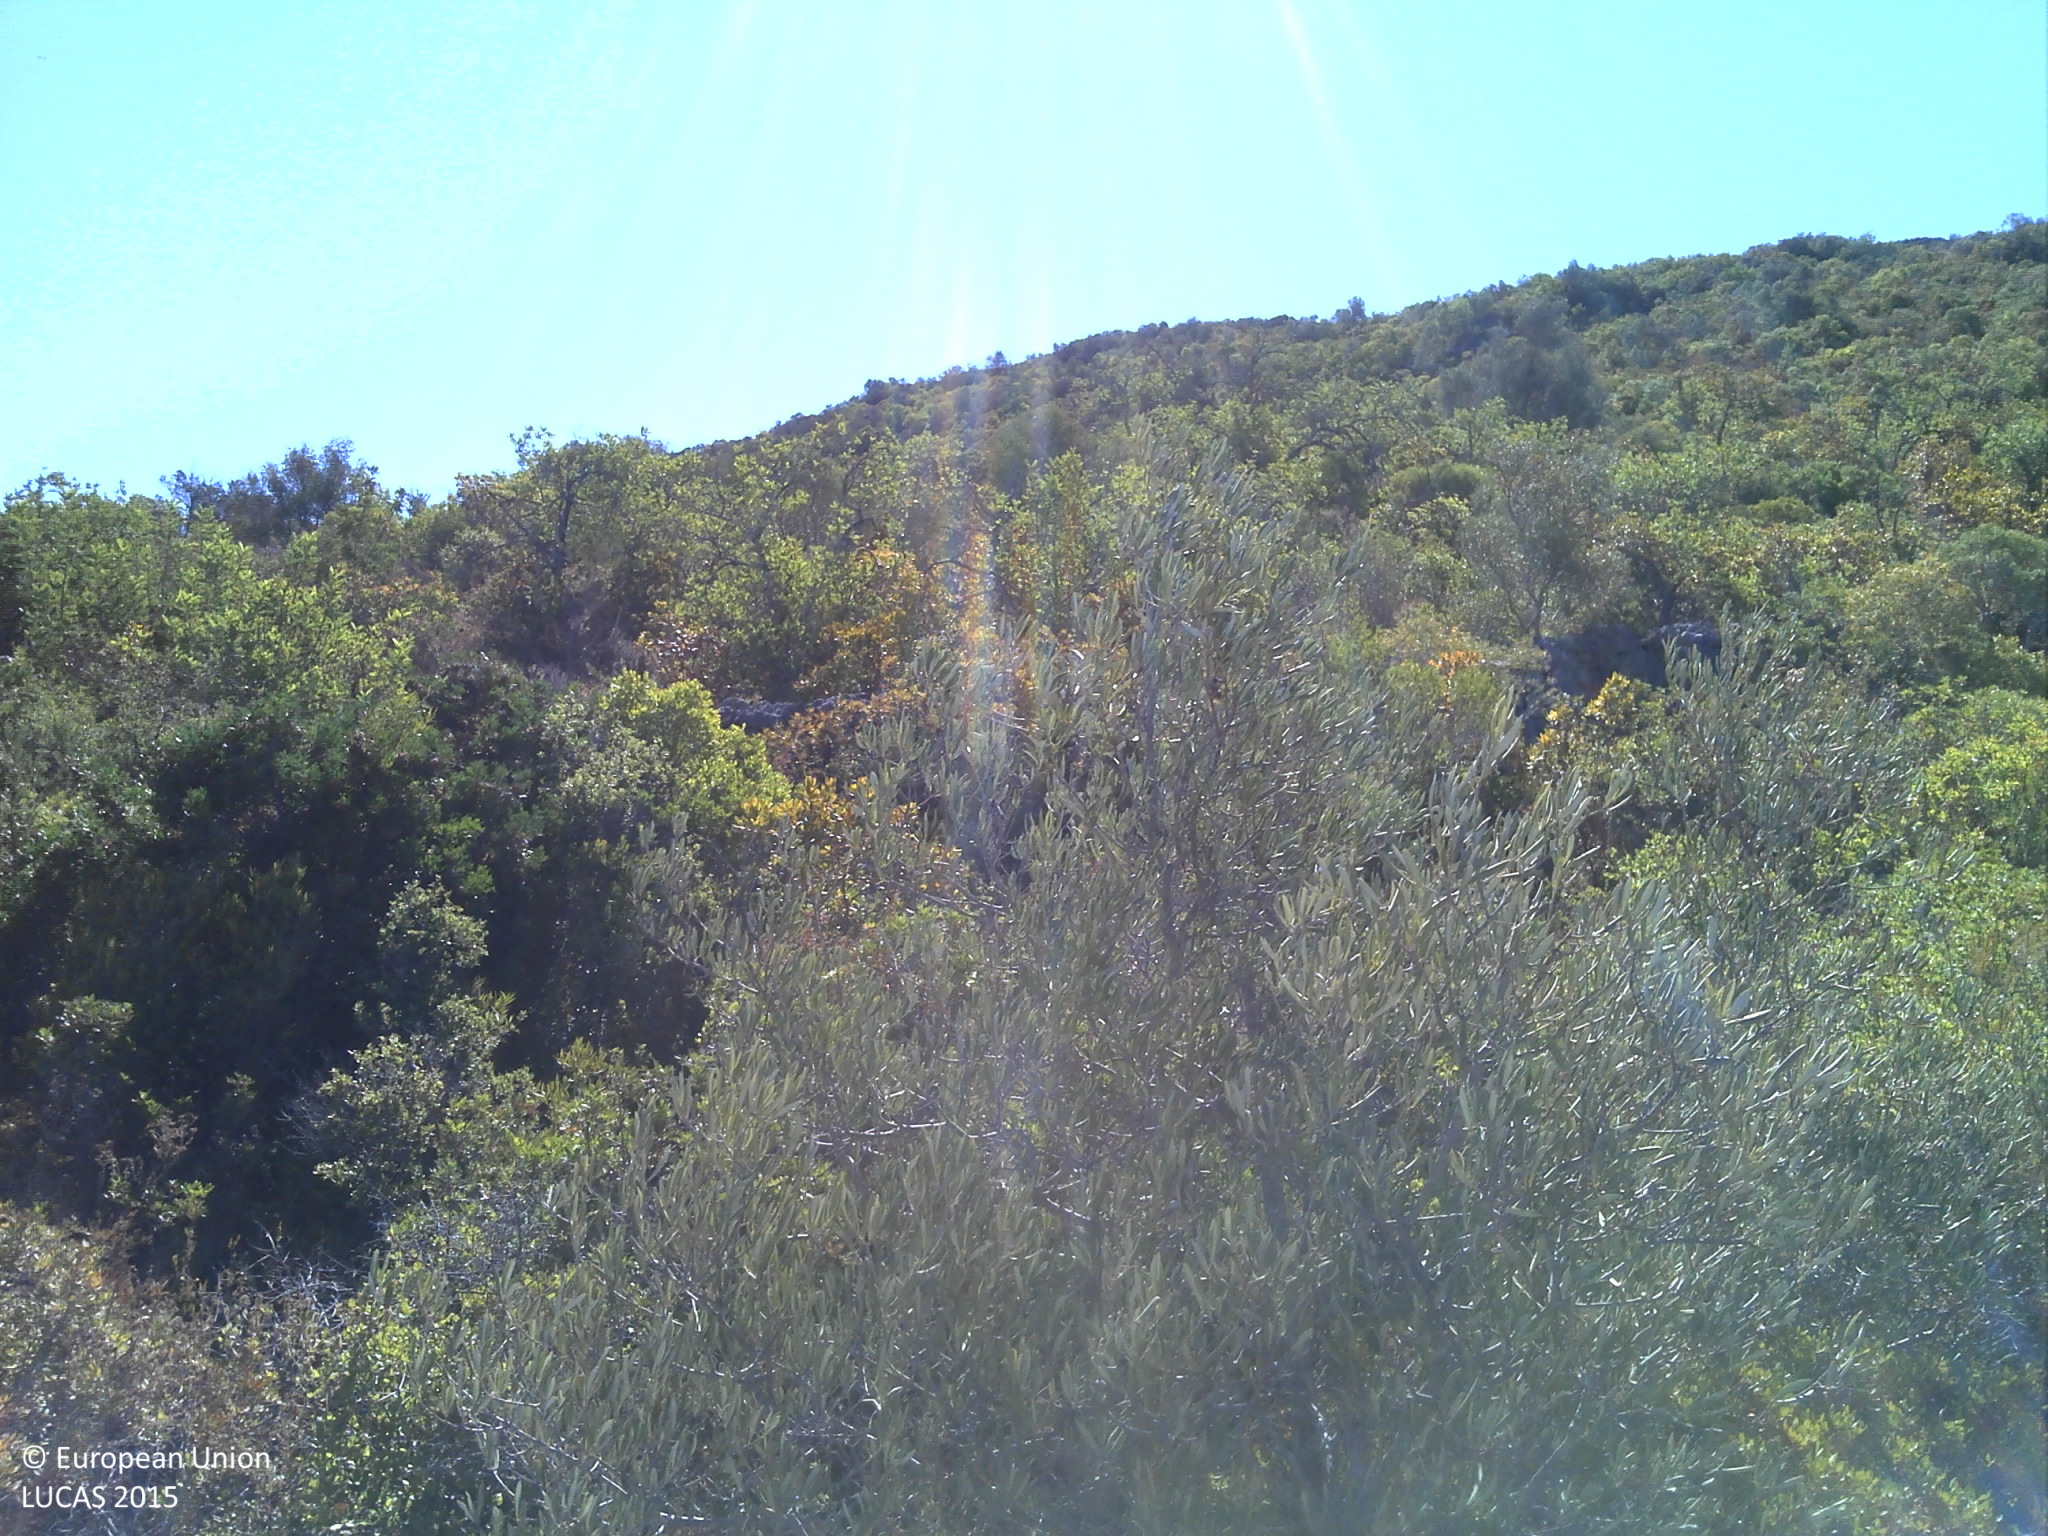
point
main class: Shrubland
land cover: Shrubland without tree cover
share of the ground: 50 - 75 %
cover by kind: shrubs 70 %, unconsolidated bare surface 30 %
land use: Semi-natural and natural areas not in use
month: September
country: PT
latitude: 37.2214
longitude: -8.1741
